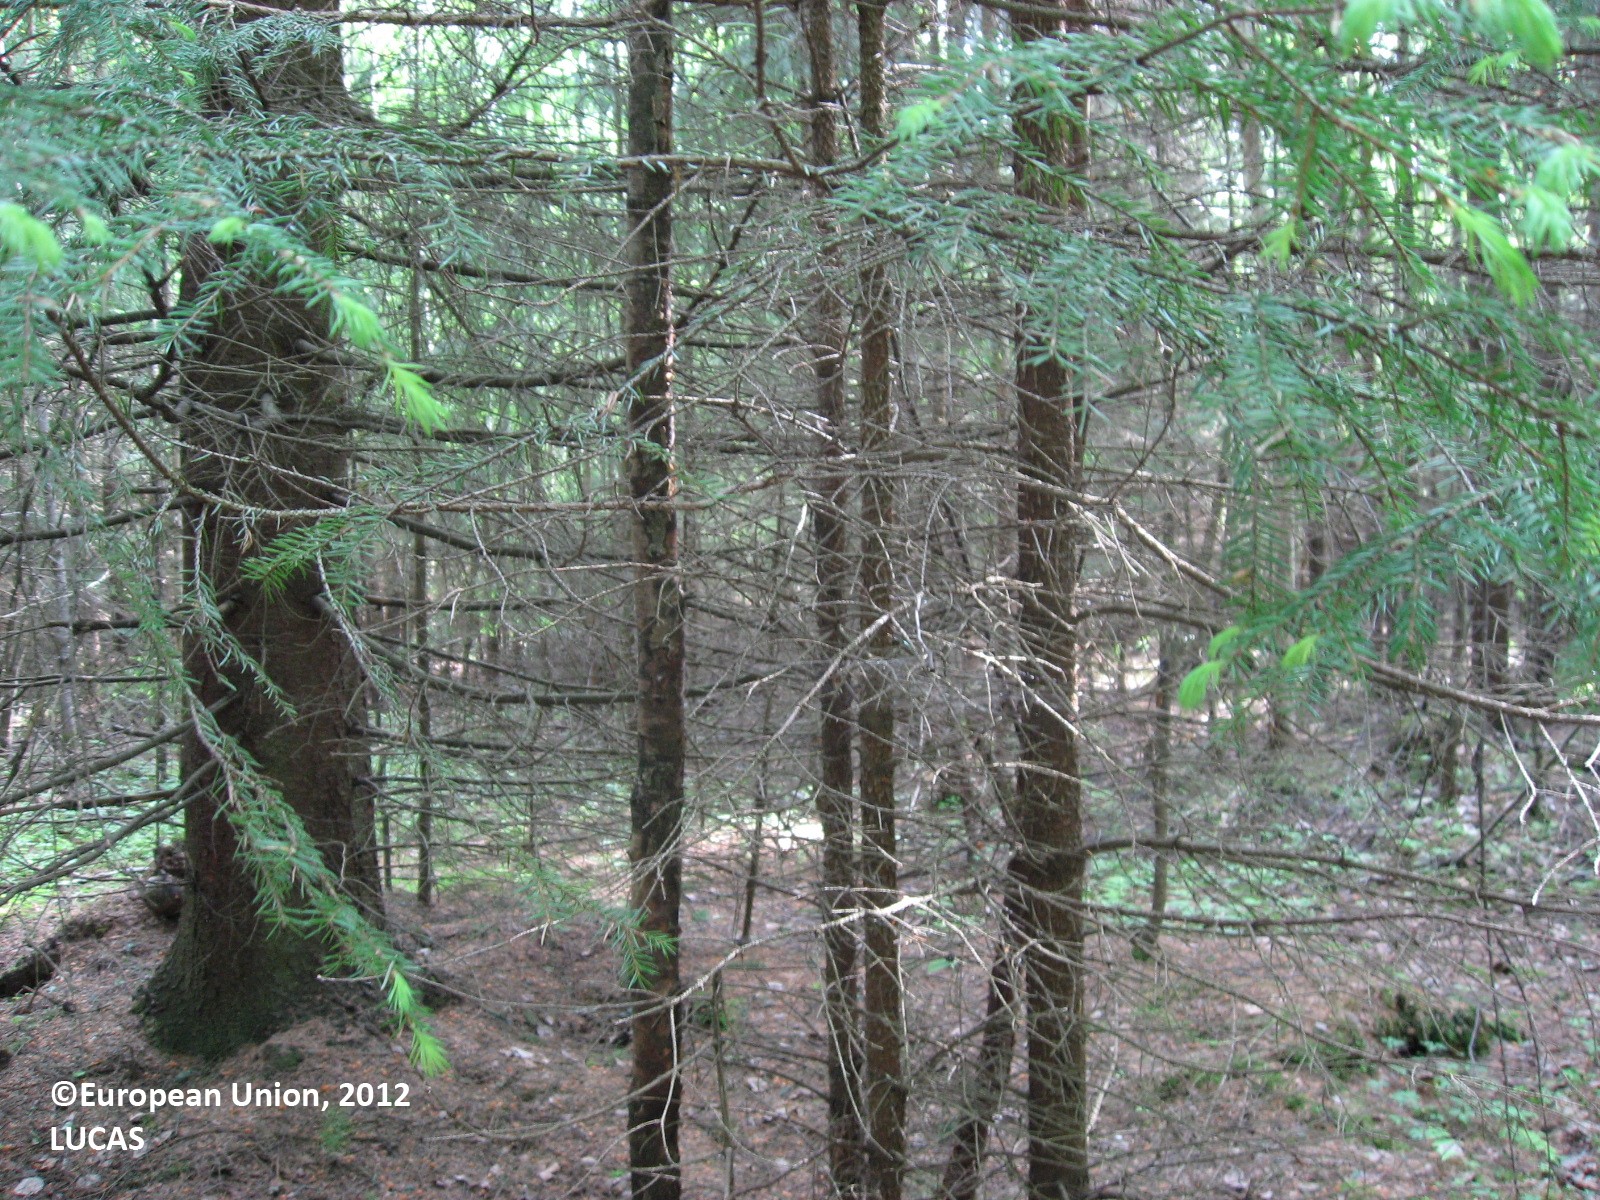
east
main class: Woodland
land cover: Spruce dominated coniferous woodland
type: boreal forest
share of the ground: > 75 %
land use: Forestry
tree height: > 5 m
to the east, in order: Spruce dominated coniferous woodland; Ditches and canals; Spruce dominated mixed woodland; Rock outcrops; Single bushes/trees; Rock outcrops; Single bushes/trees; Rock outcrops; Spruce dominated mixed woodland; Rock outcrops
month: June
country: FI
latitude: 60.3539
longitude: 24.9241
